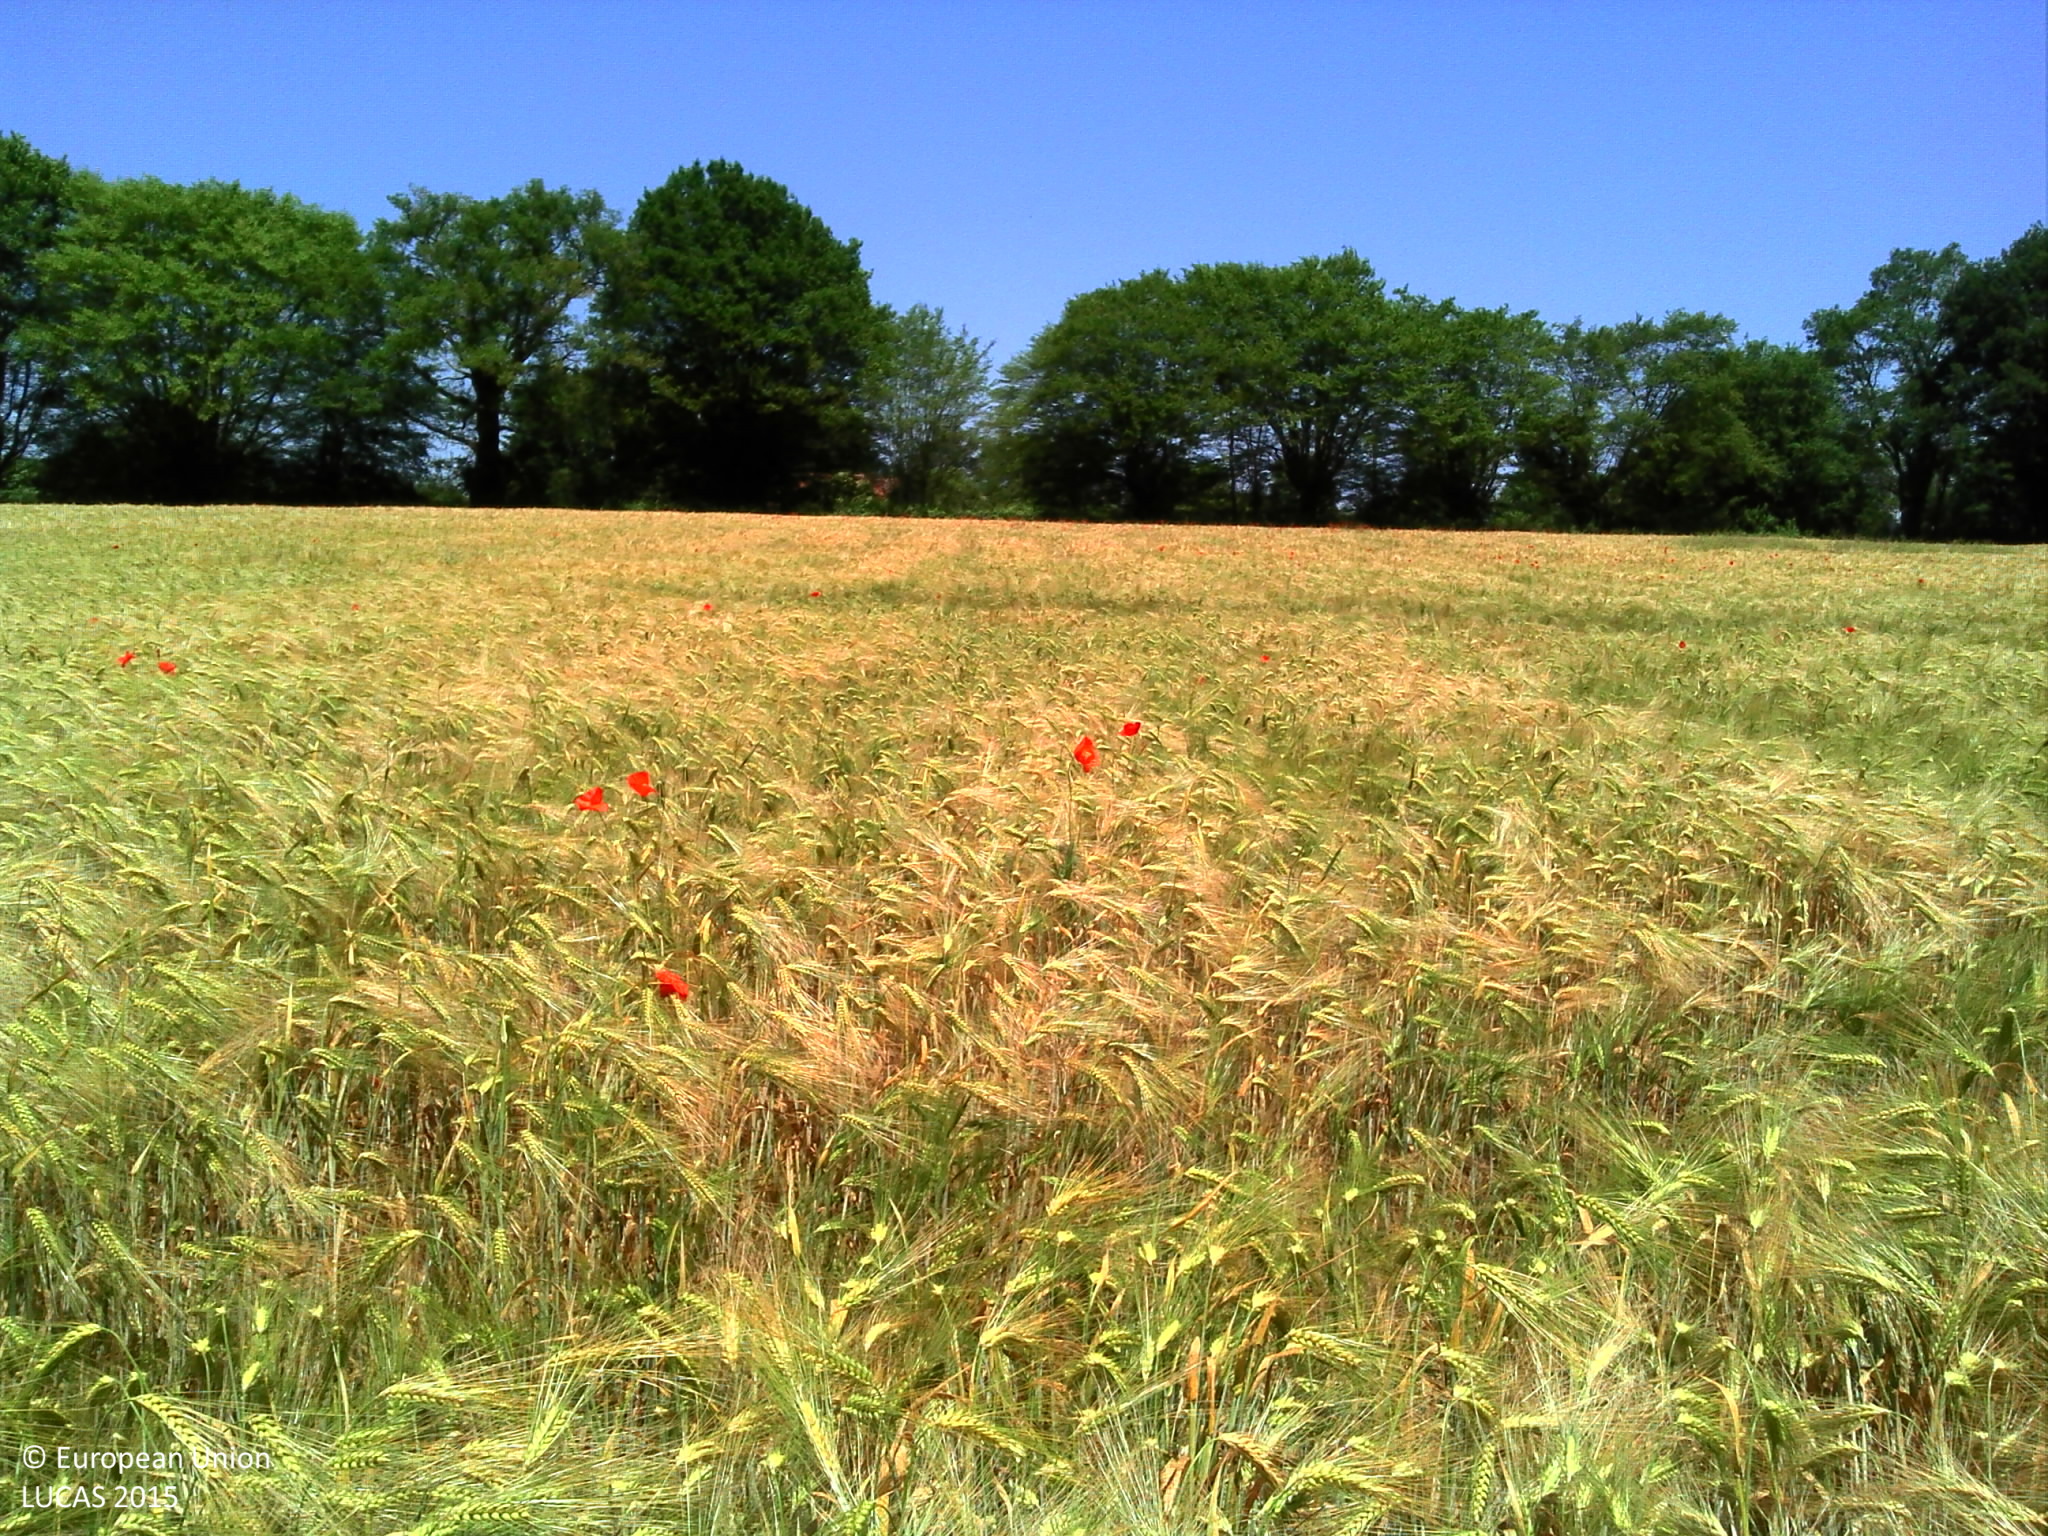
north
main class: Cropland
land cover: Barley
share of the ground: > 75 %
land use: Agriculture (excluding fallow land and kitchen gardens)
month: June
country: FR
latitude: 46.8955
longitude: 2.9473
